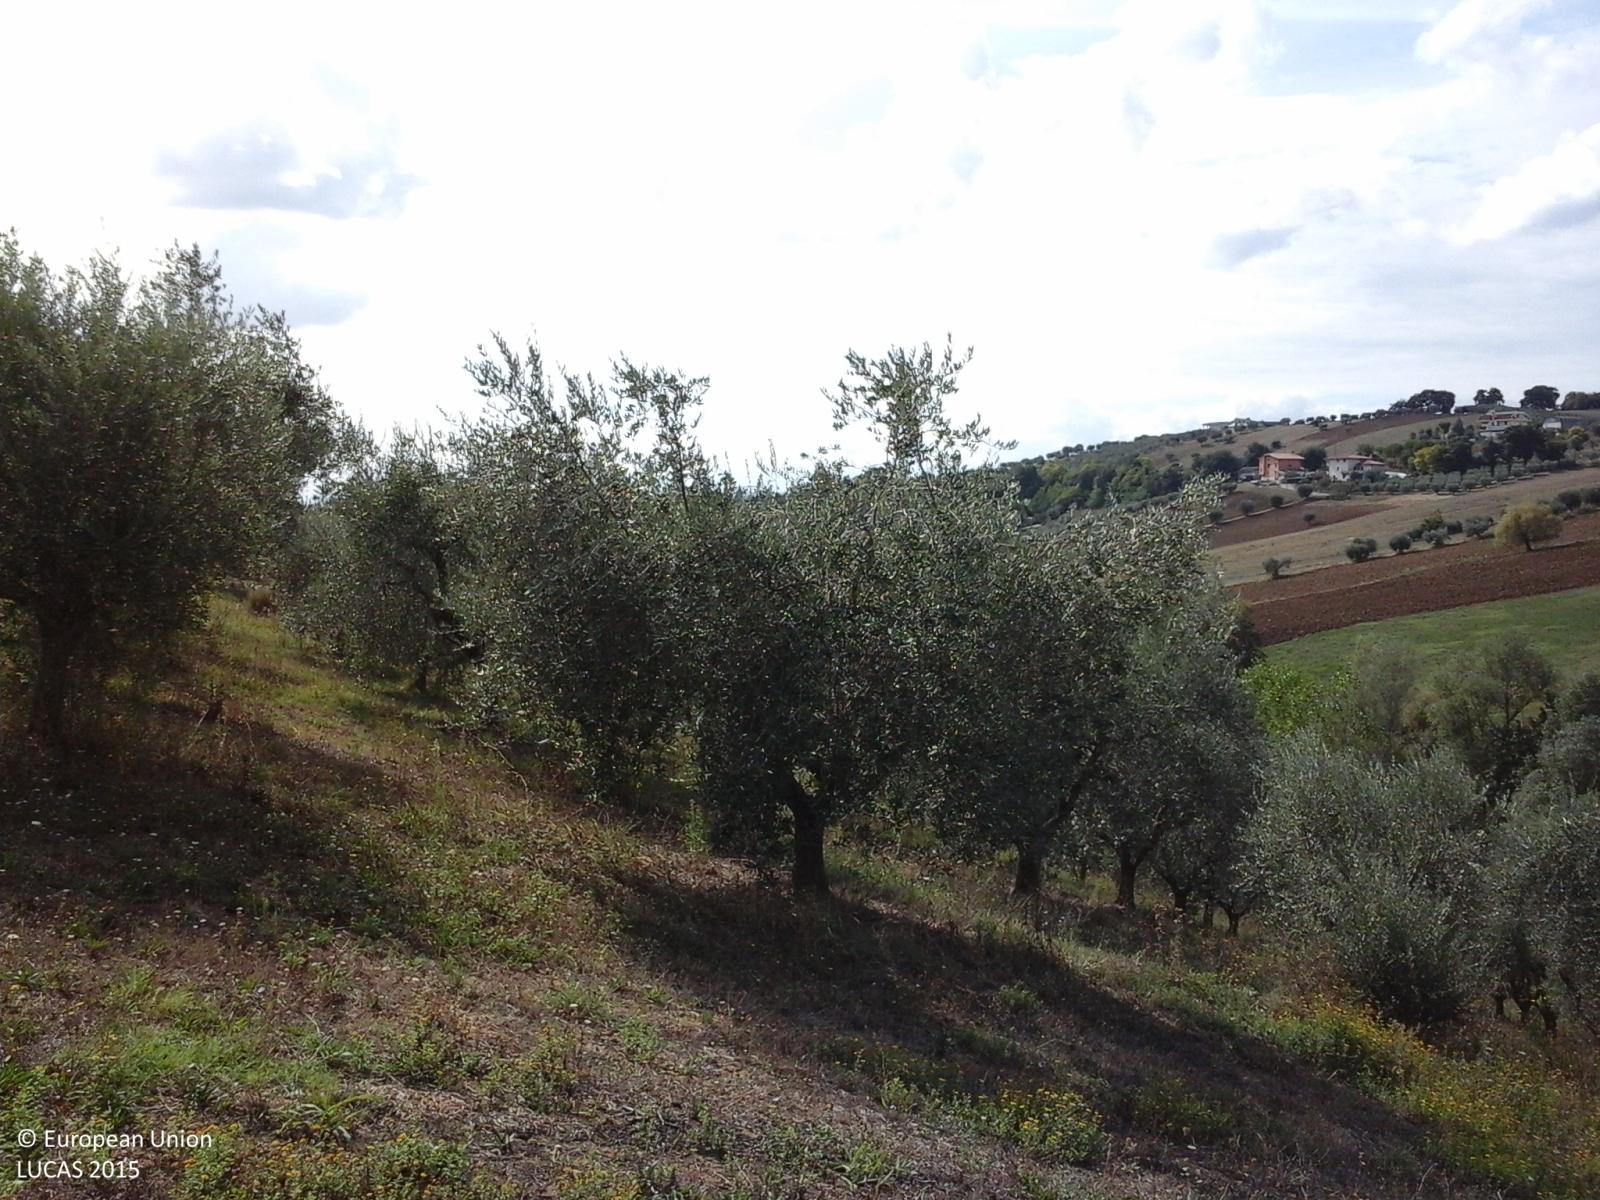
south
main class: Cropland
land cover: Tomatoes
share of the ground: > 75 %
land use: Kitchen garden
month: September
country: IT
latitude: 42.8351
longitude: 13.8186
